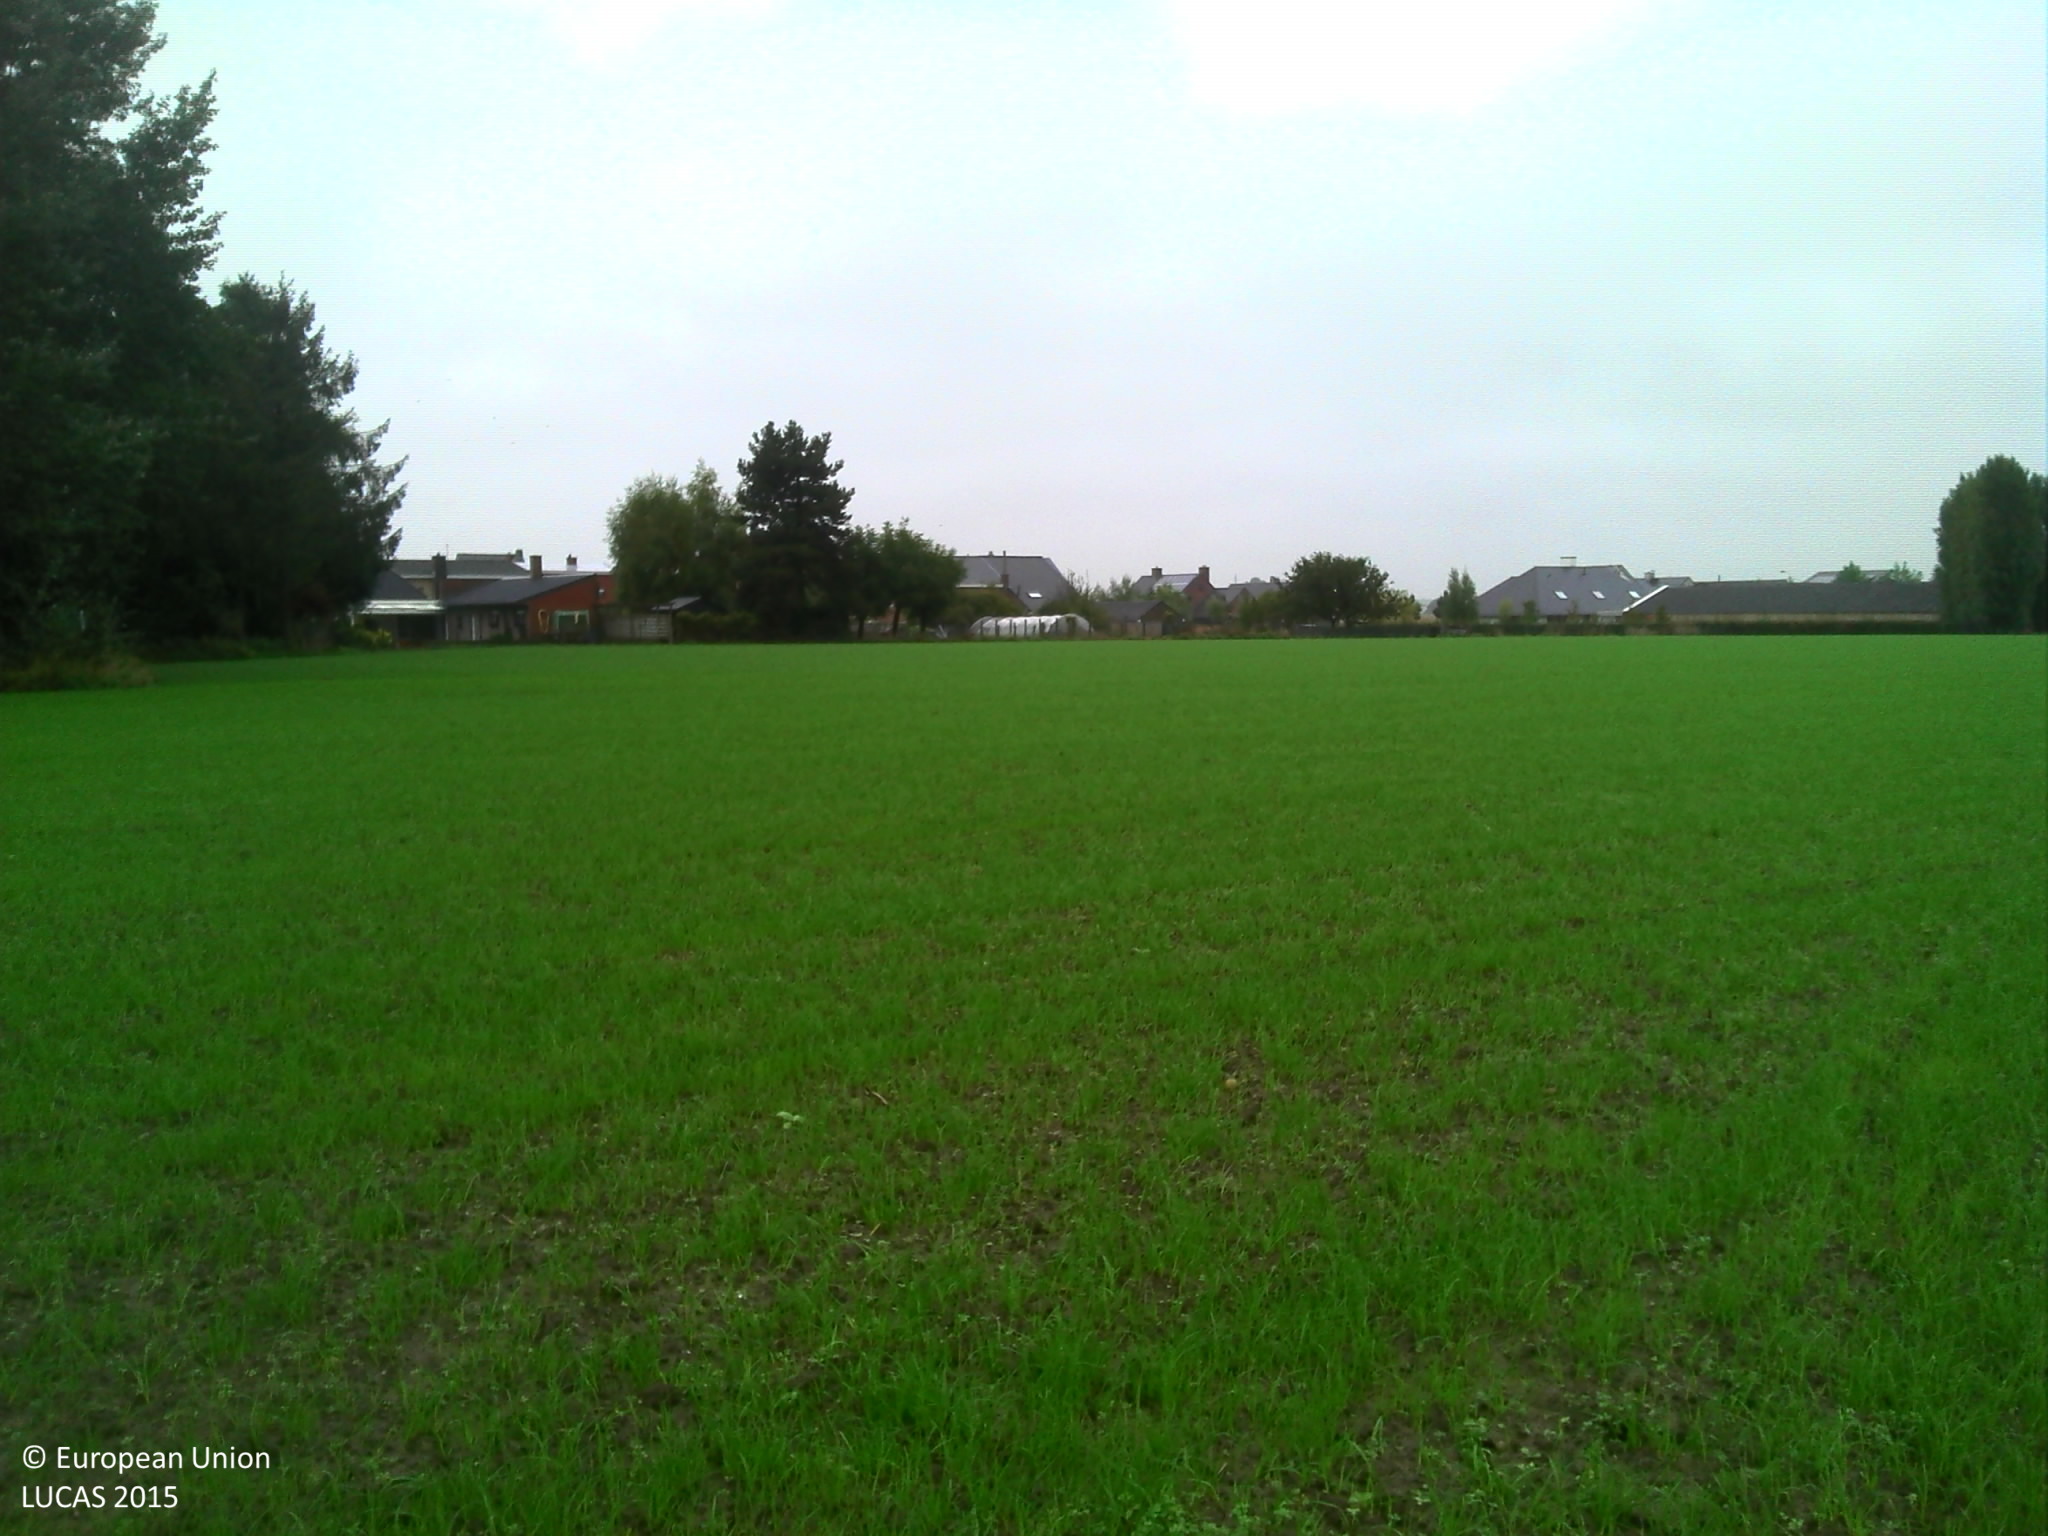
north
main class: Cropland
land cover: Temporary grasslands
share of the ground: 50 - 75 %
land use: Agriculture (excluding fallow land and kitchen gardens)
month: October
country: BE
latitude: 50.9530
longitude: 2.8573
